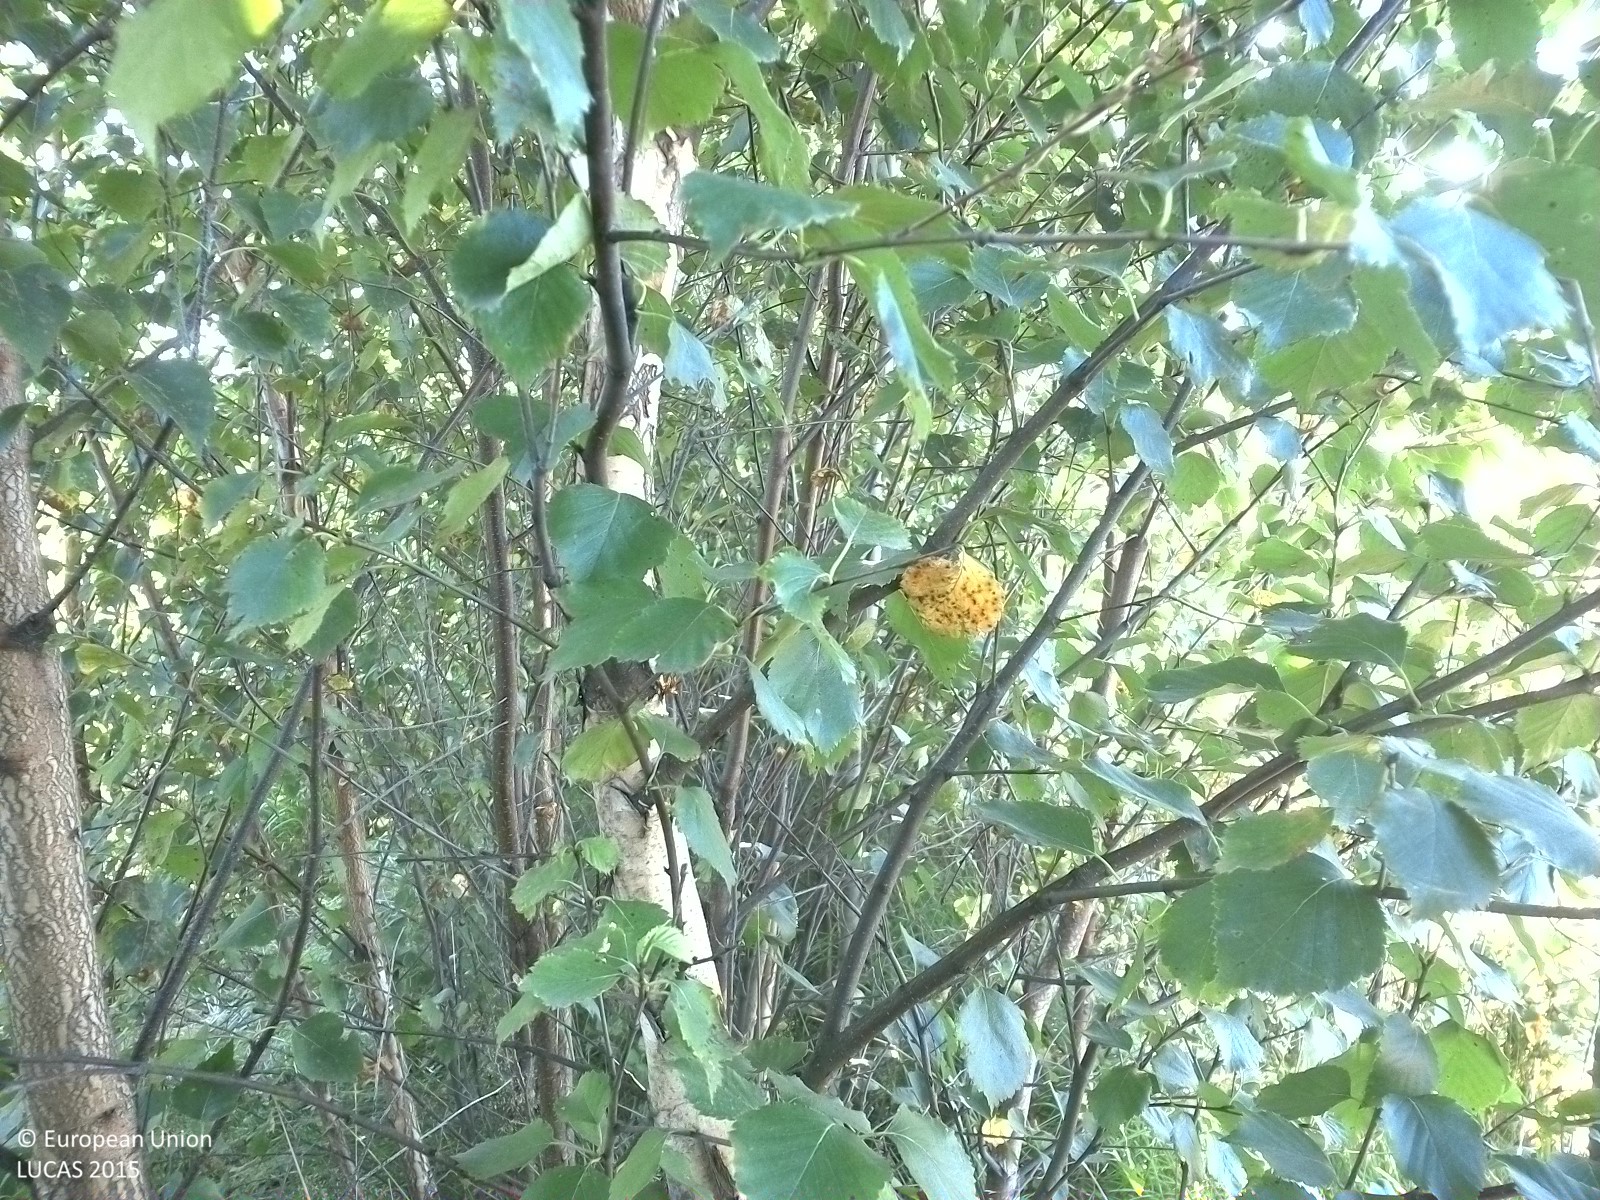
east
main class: Woodland
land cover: Broadleaved woodland
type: hemiboreal forest and nemoral coniferous forest and mixed broadleaved-coniferous forest
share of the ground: 50 - 75 %
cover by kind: broadleaved forest trees 70 %, herbaceous plants 30 %
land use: Semi-natural and natural areas not in use
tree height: < 5 m
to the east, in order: Broadleaved woodland; Fences; Grass margins; Ditches and canals; Paved roads, cycling and walking lanes; Grassland with sparse tree/shrub cover; Broadleaved woodland; Pine dominated mixed woodland; Paved roads, cycling and walking lanes
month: August
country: SE
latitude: 59.2397
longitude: 15.1278
